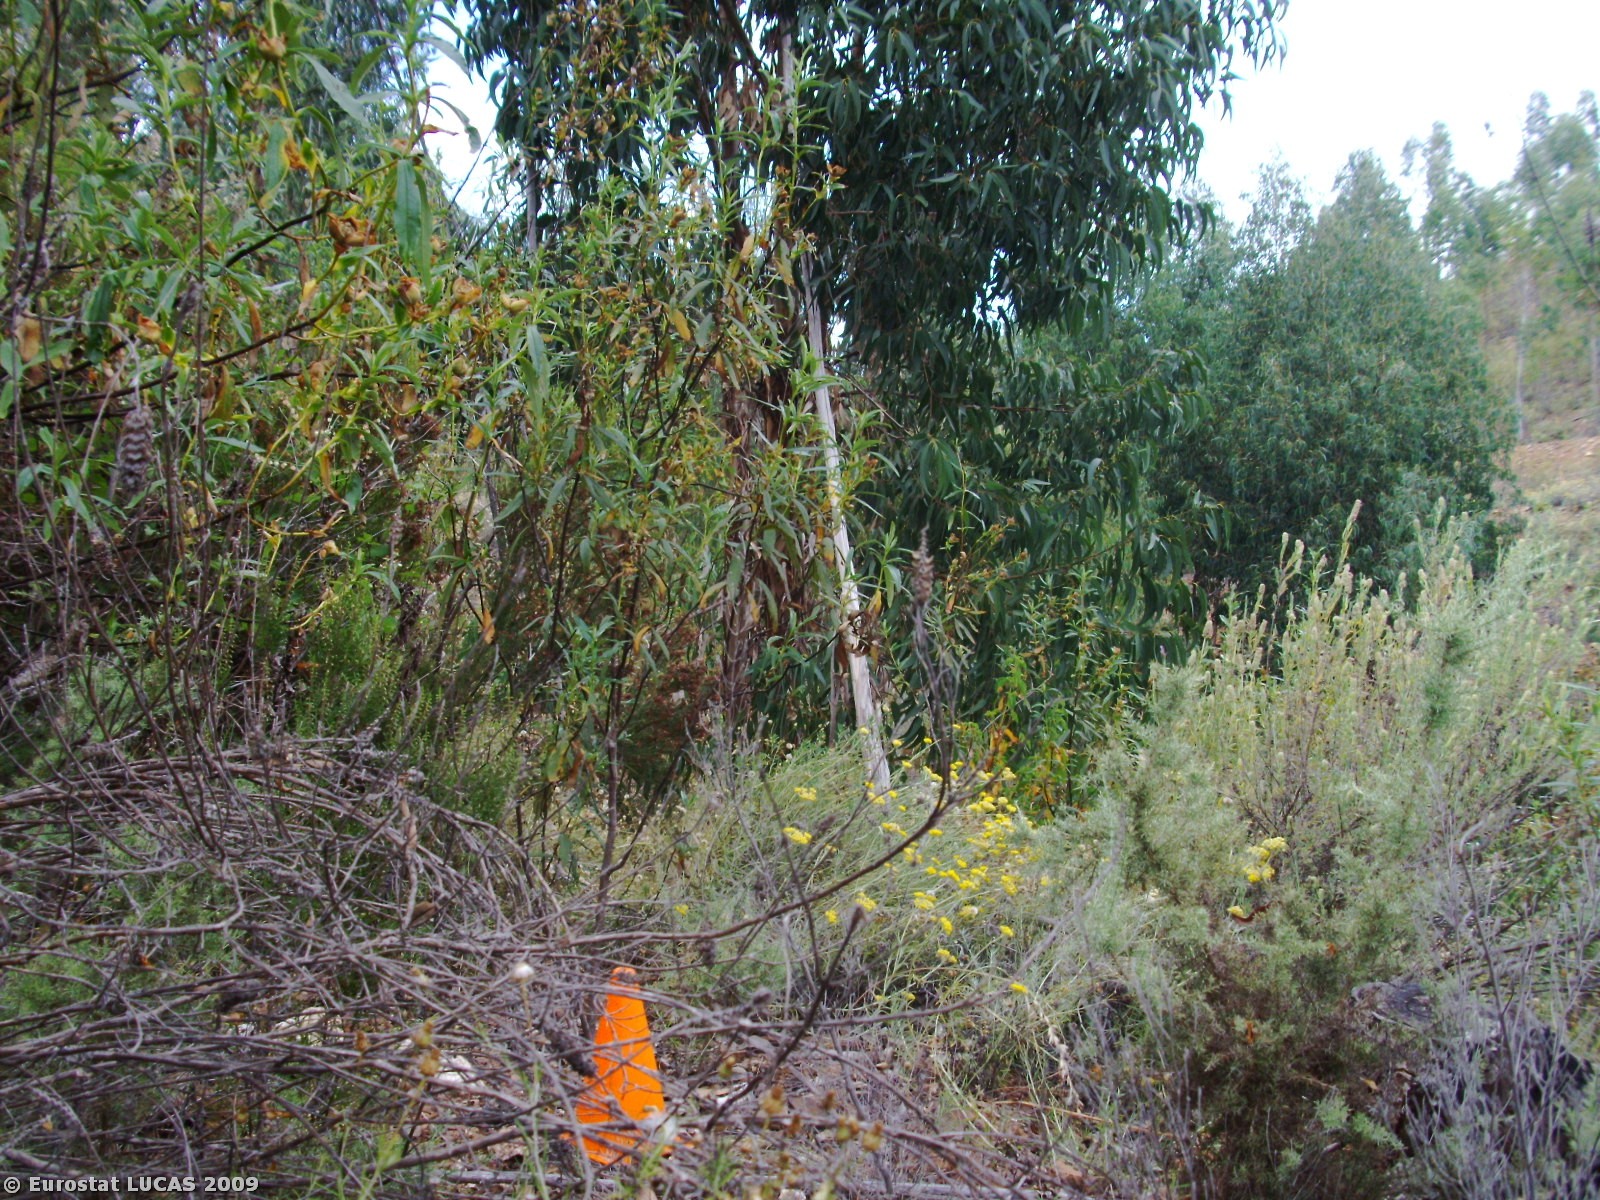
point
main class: Woodland
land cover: Broadleaved woodland
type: plantations and self-sown exotic forest
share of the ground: 25 - 50 %
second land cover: Shrubland with sparse tree cover
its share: 25 - 50 %
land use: Forestry
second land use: Unused
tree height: > 5 m
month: June
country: PT
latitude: 37.2400
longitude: -8.4563
